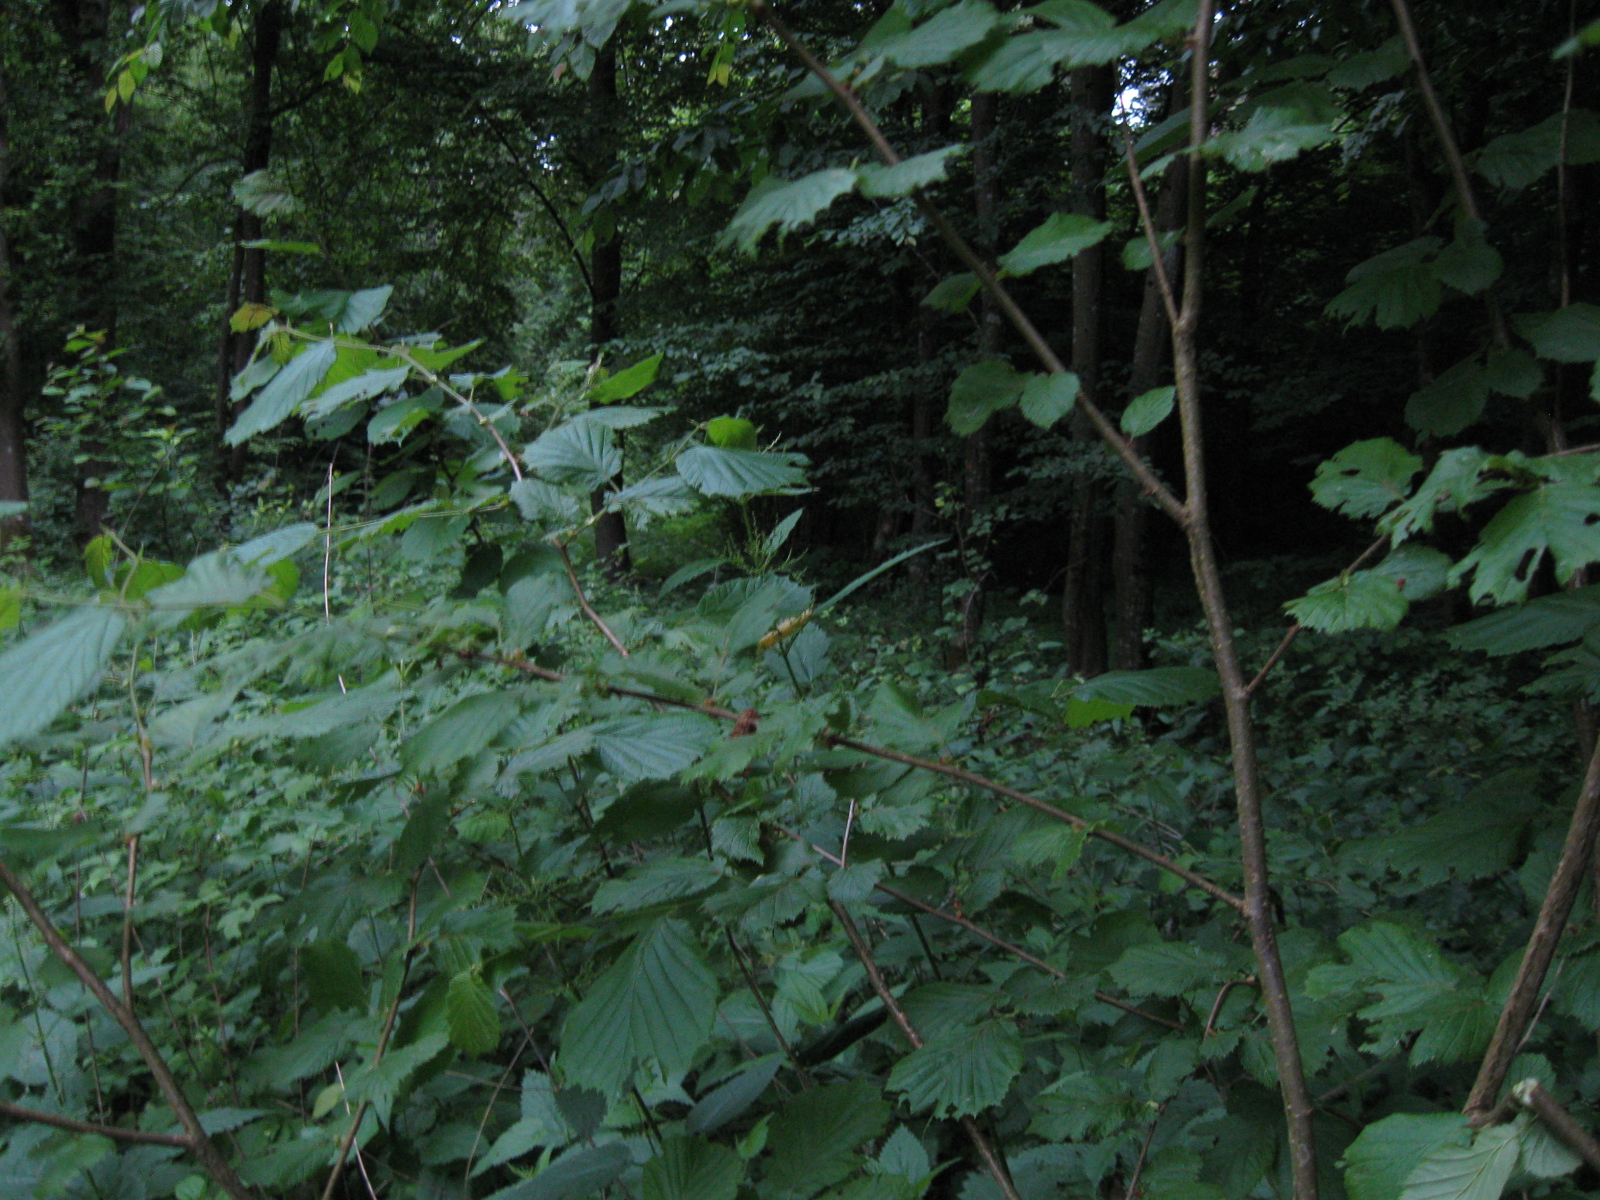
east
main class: Woodland
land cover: Broadleaved woodland
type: non-riverine alder, birch or aspen forest
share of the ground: > 75 %
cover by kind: broadleaved forest trees 80 %, coniferous forest trees 10 %, herbaceous plants 10 %
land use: Forestry
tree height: > 5 m
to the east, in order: Broadleaved woodland; Other mixed woodland; Broadleaved woodland; Other mixed woodland
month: June
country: LT
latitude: 54.6656
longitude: 24.4744
